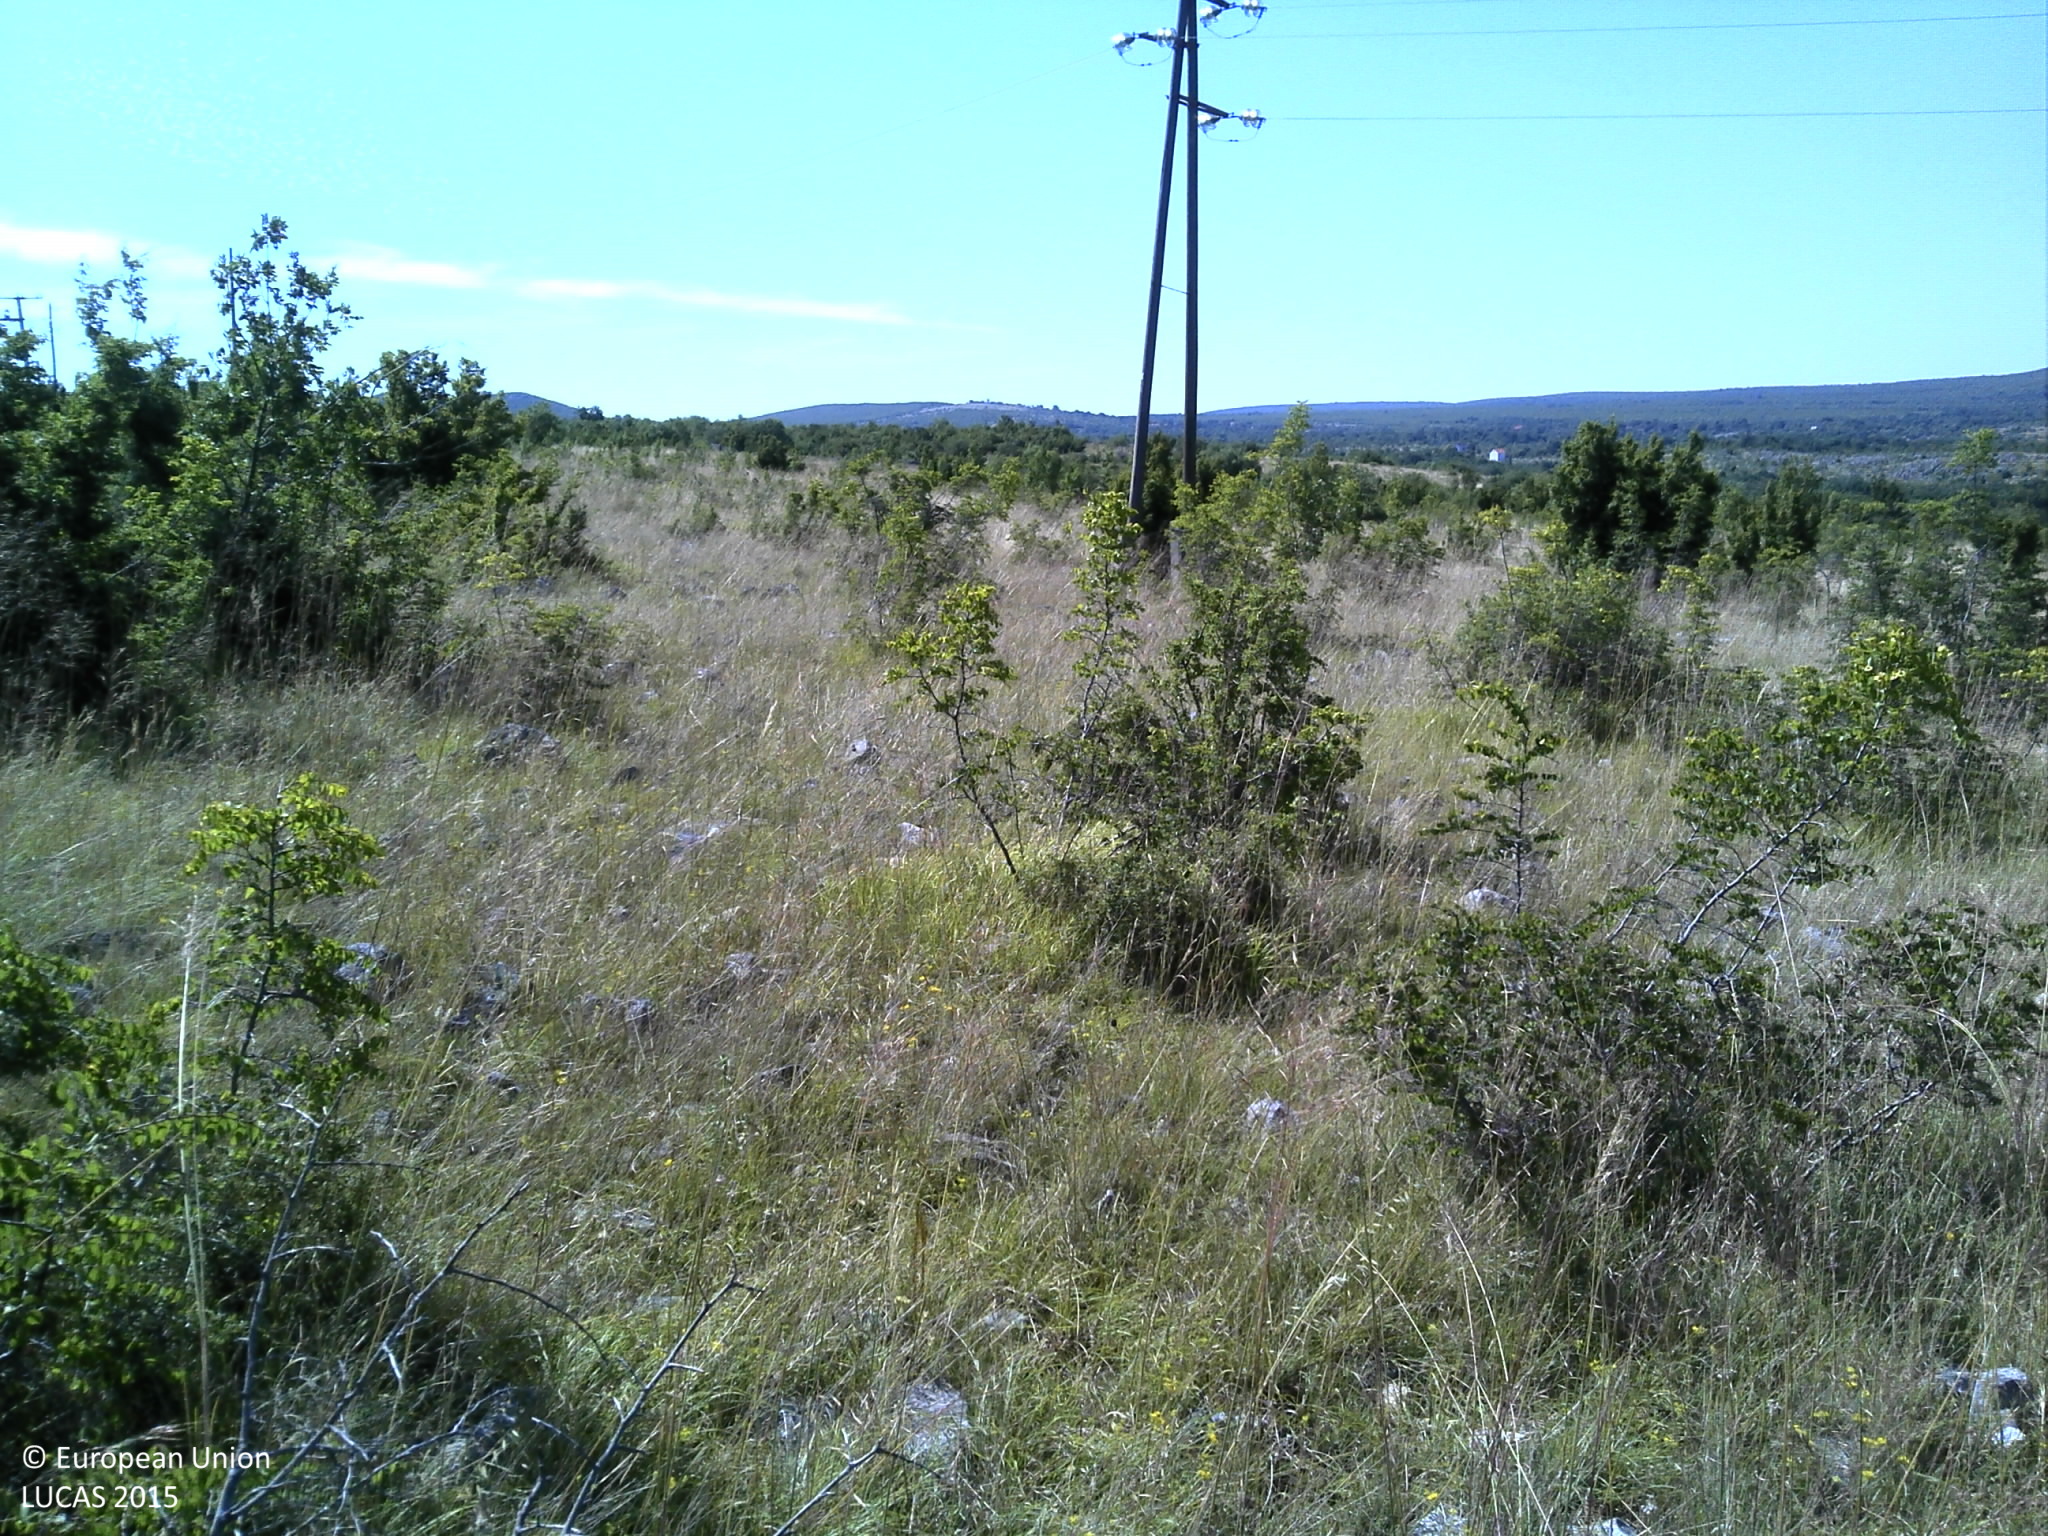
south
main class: Shrubland
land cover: Shrubland with sparse tree cover
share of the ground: 25 - 50 %
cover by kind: herbaceous plants 50 %, shrubs 40 %, broadleaved forest trees 5 %, unconsolidated bare surface 5 %
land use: Semi-natural and natural areas not in use
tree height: < 5 m
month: June
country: HR
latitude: 44.1074
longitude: 15.9518
